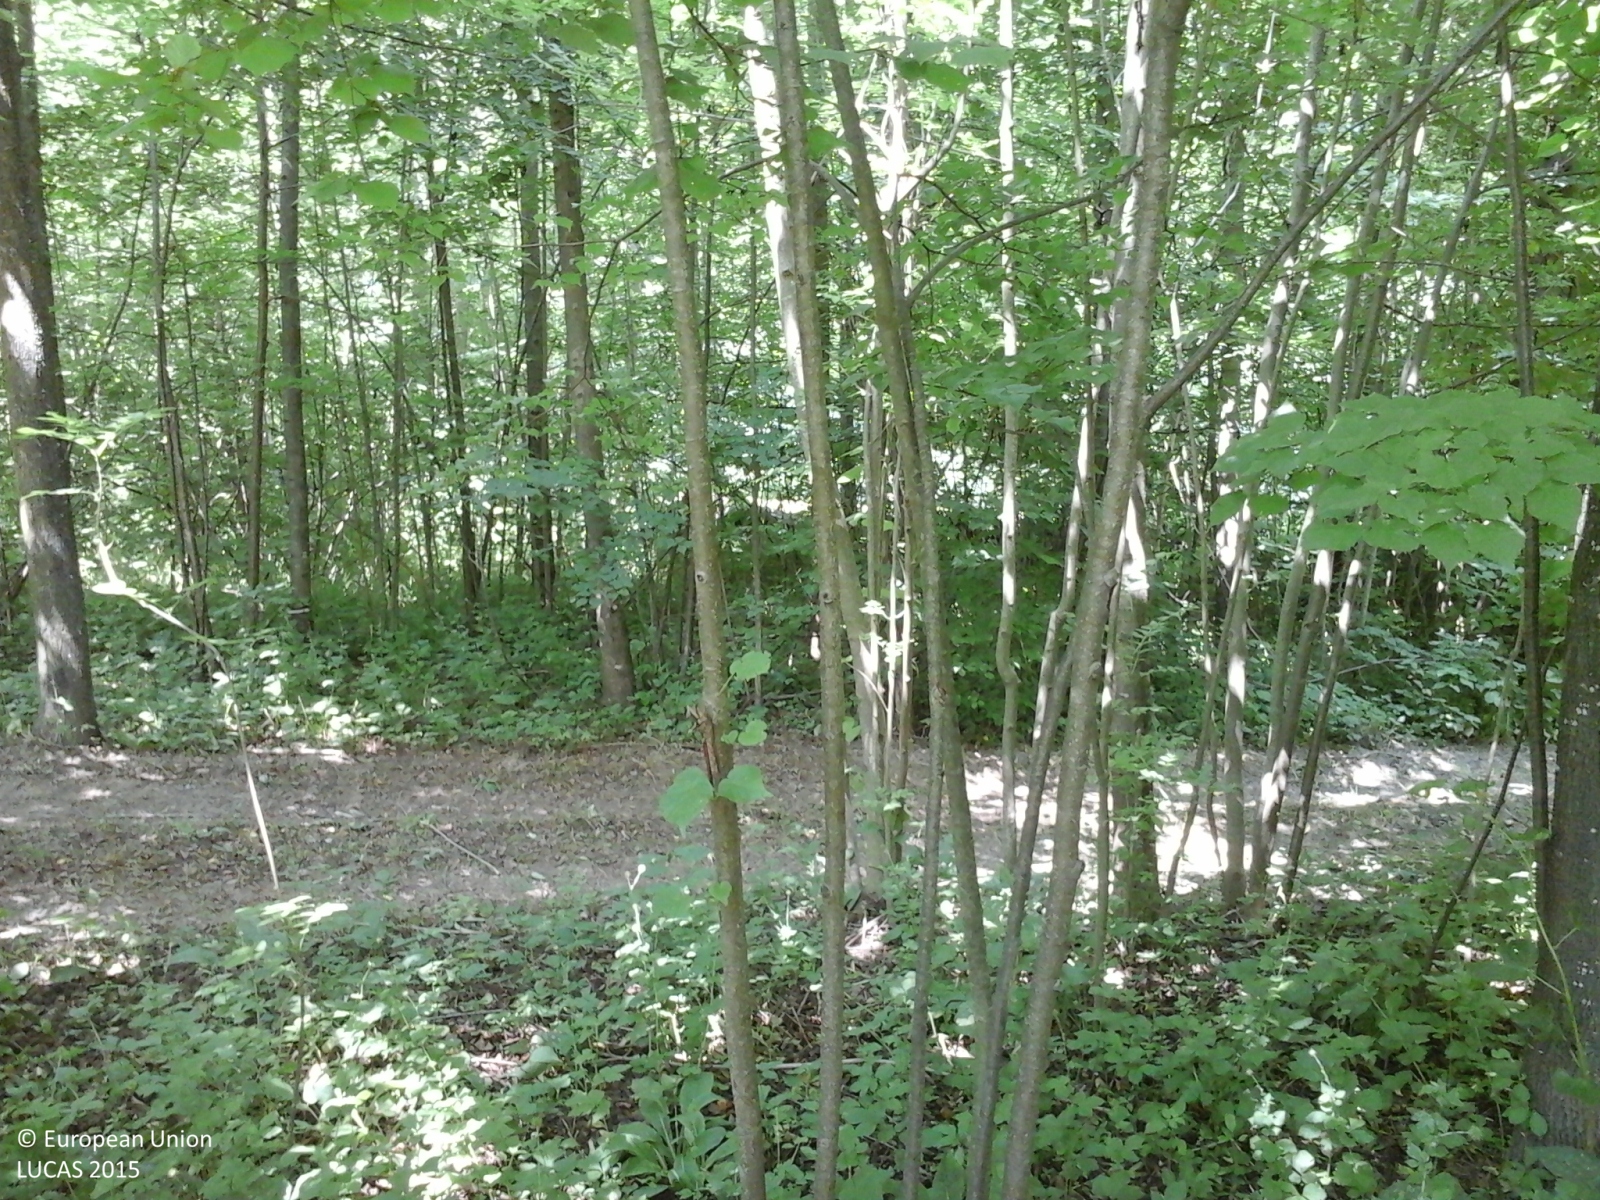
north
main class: Woodland
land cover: Broadleaved woodland
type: mesophytic deciduous forest
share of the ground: > 75 %
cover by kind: broadleaved forest trees 90 %, shrubs 10 %
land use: Forestry
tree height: > 5 m
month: June
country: IT
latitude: 44.5680
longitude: 7.2981
